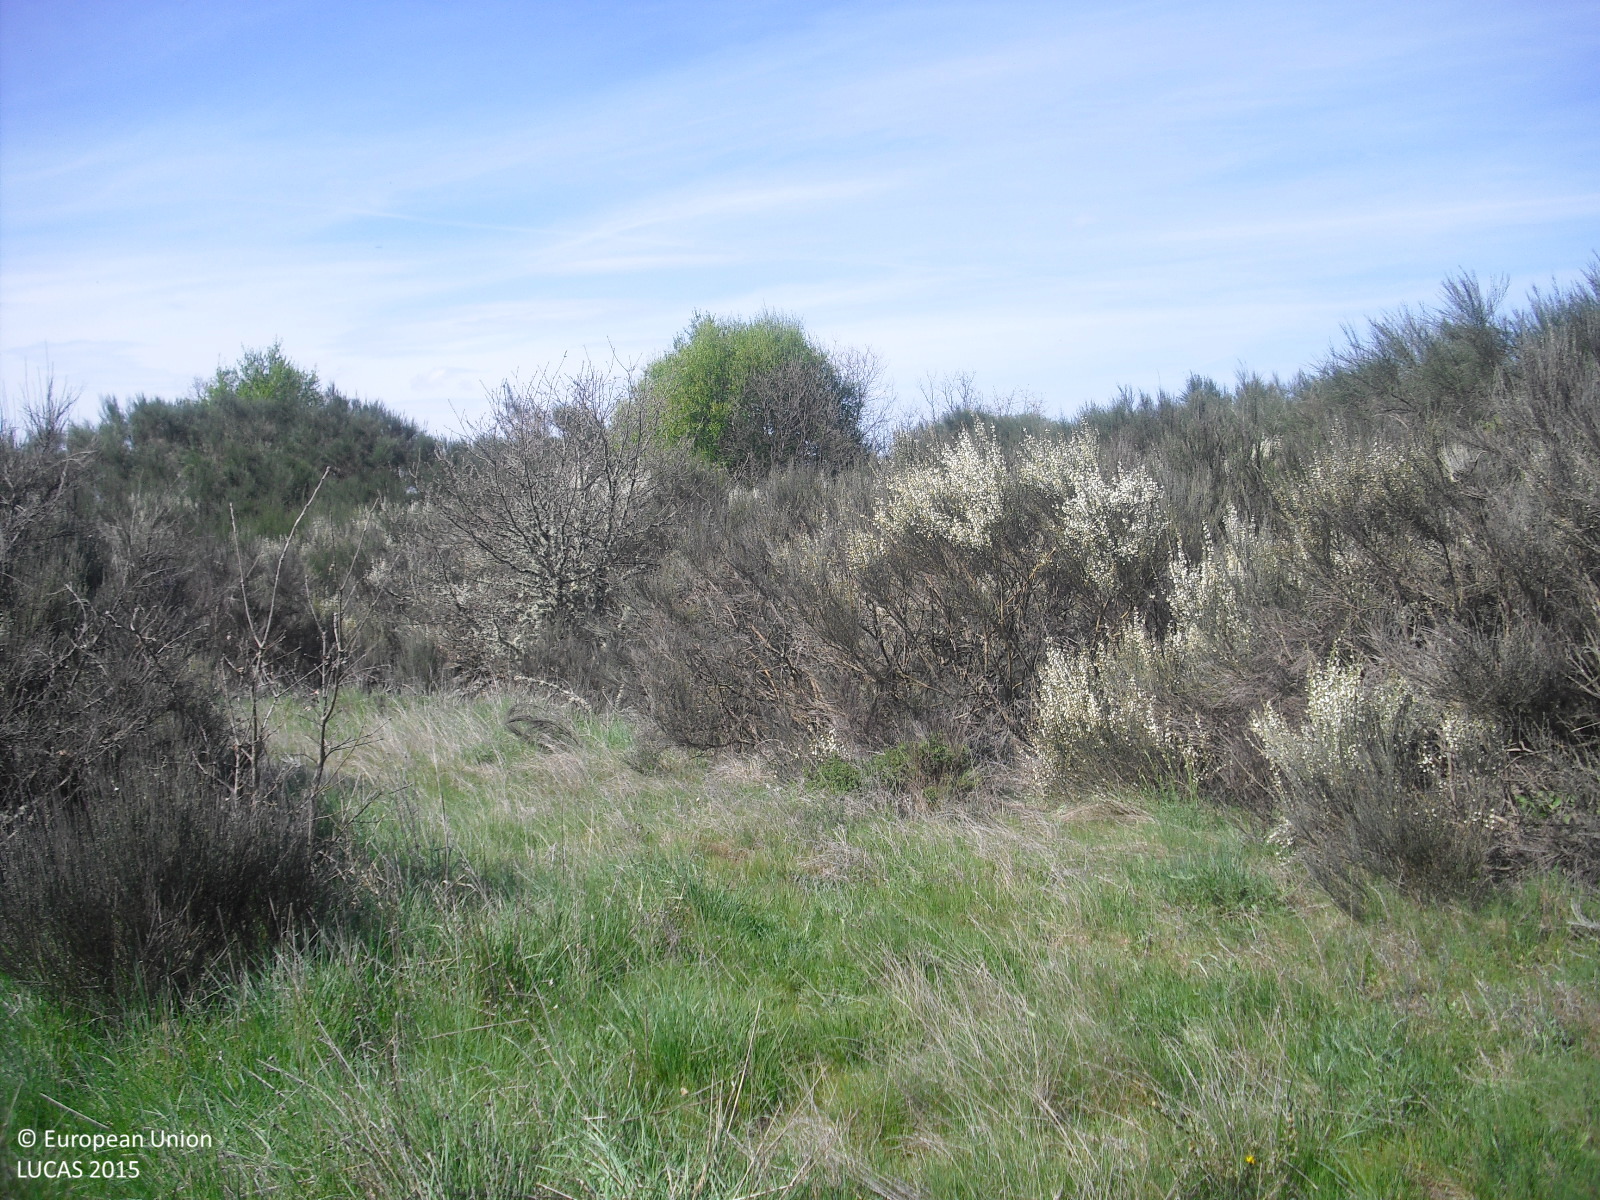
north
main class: Artificial land
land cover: Non built-up linear features
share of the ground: > 75 %
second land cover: Grassland without tree/shrub cover
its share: > 75 %
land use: Road transport
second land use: Agriculture (excluding fallow land and kitchen gardens)
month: April
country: ES
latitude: 41.9574
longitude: -7.6441
